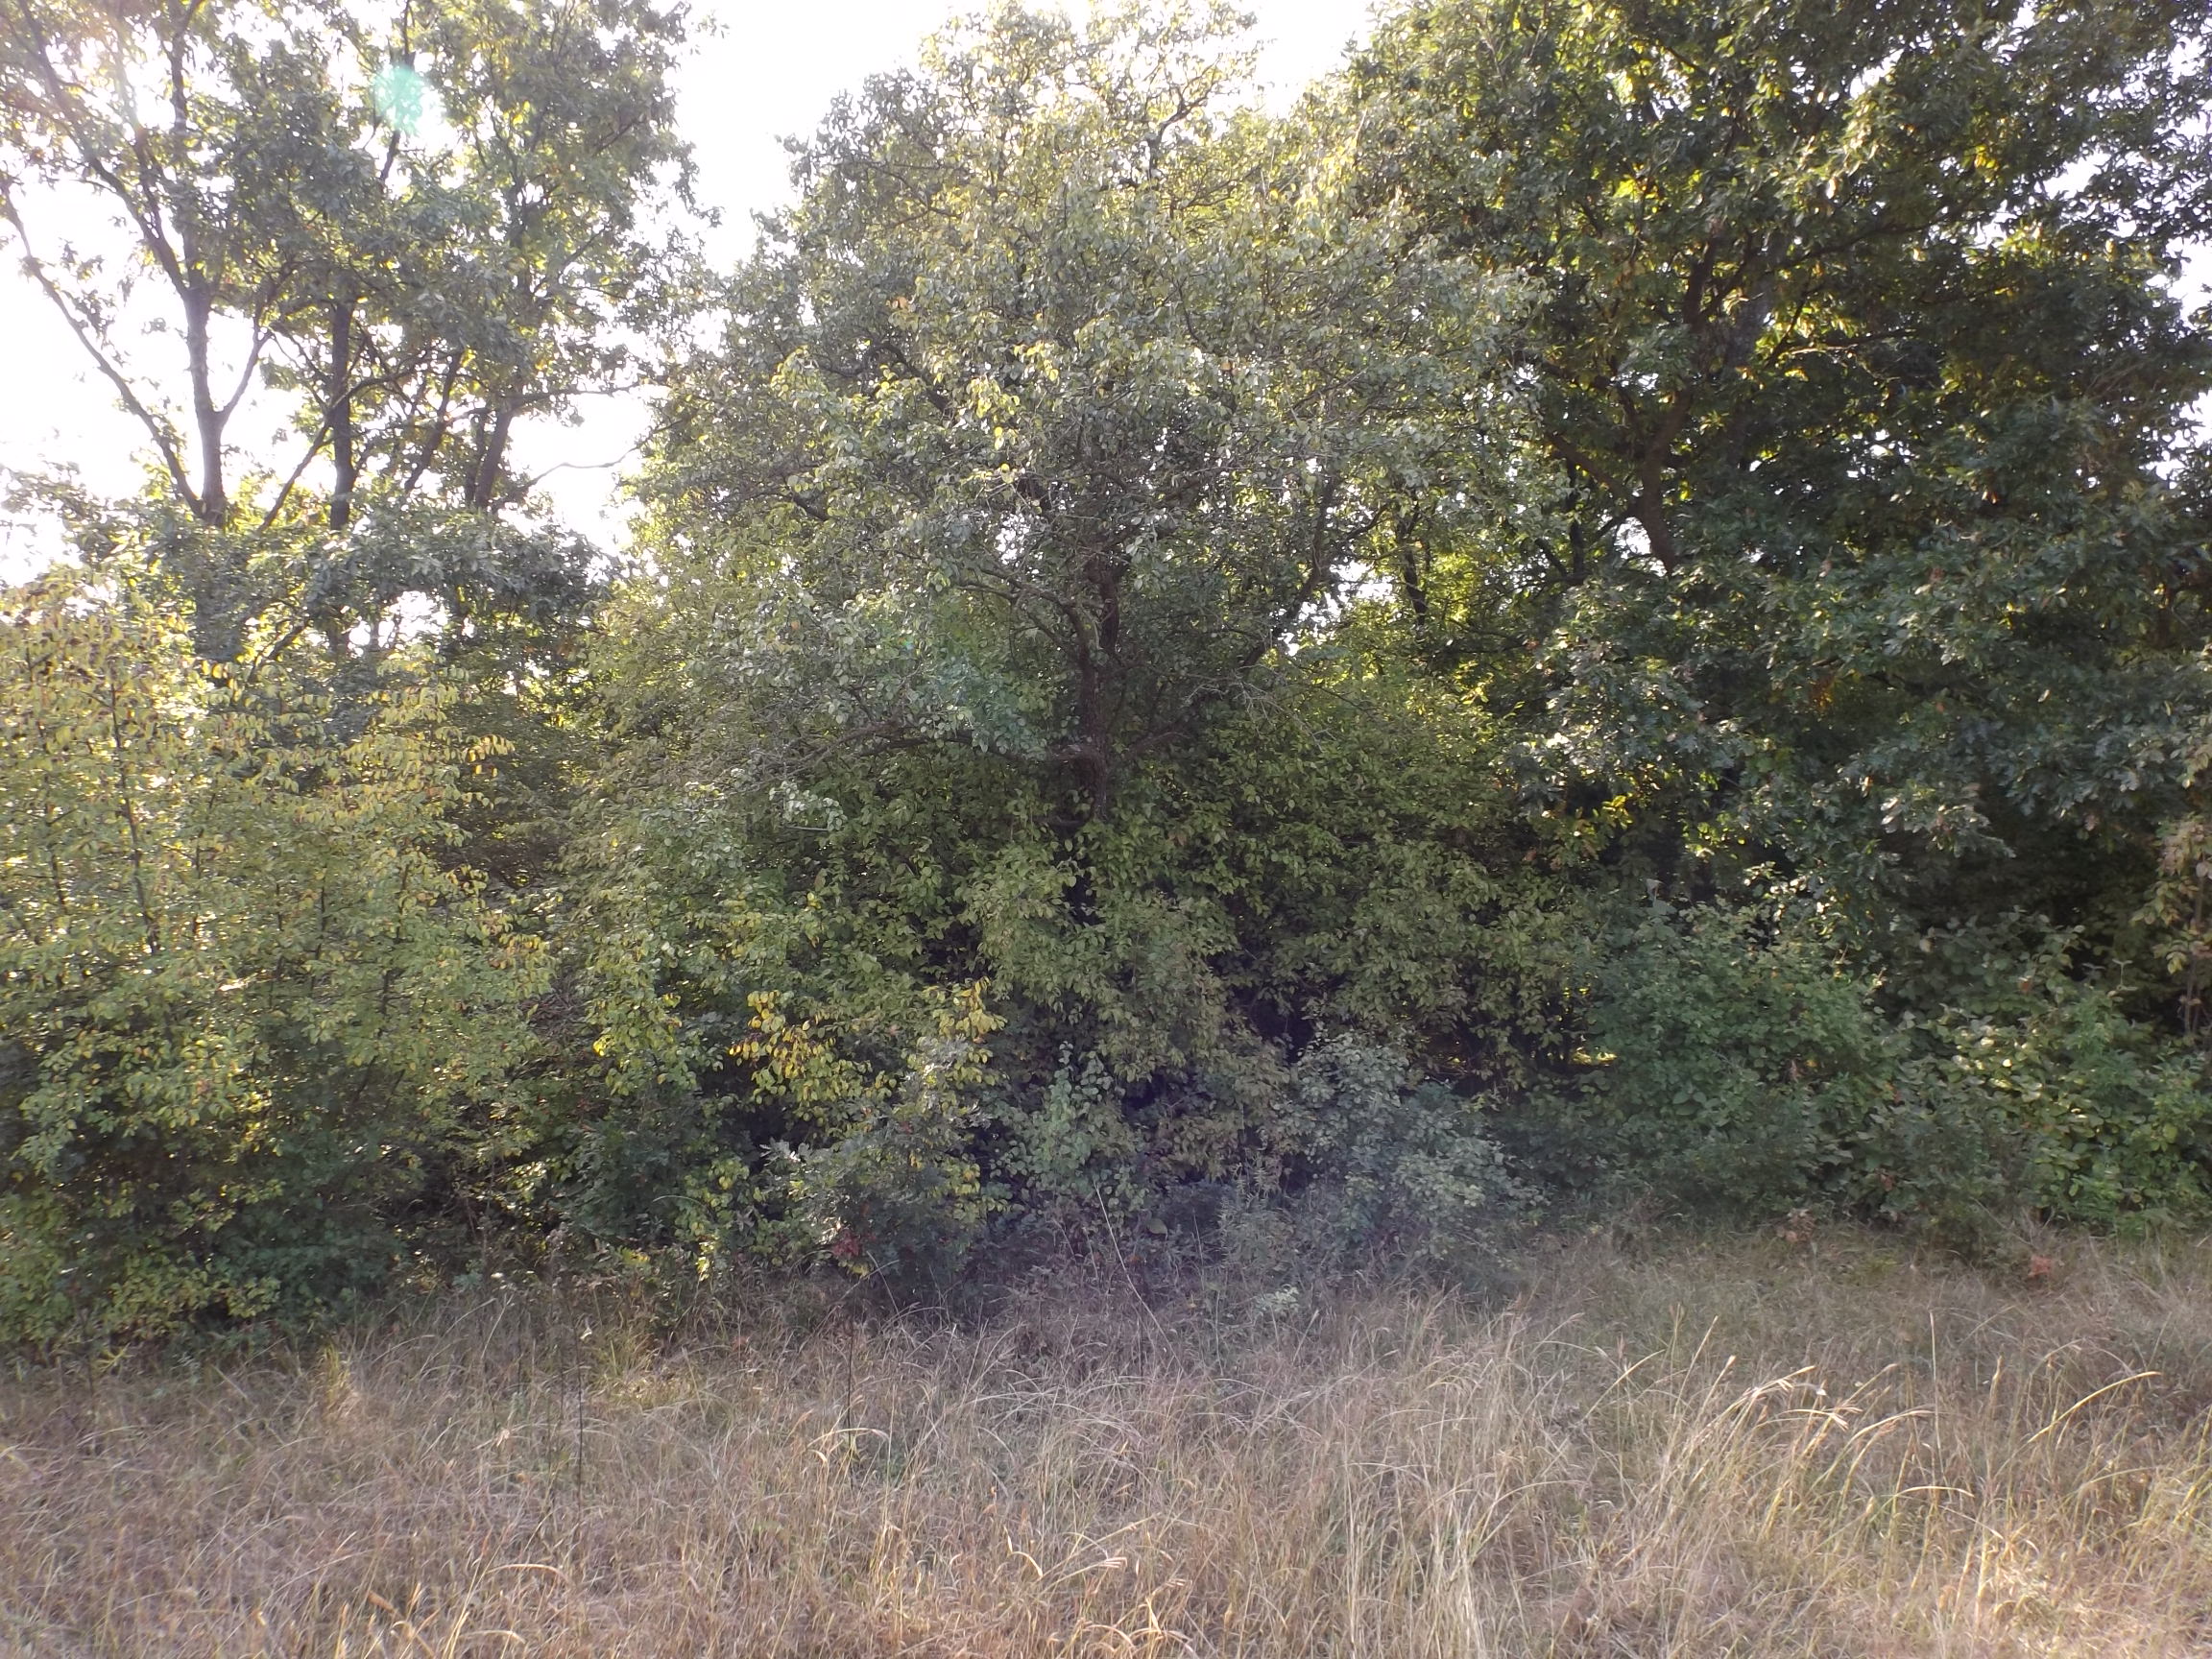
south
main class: Grassland
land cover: Grassland with sparse tree/shrub cover
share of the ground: > 75 %
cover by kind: herbaceous plants 90 %, broadleaved forest trees 5 %, shrubs 5 %
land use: Semi-natural and natural areas not in use
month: October
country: BG
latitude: 43.1546
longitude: 27.2251
